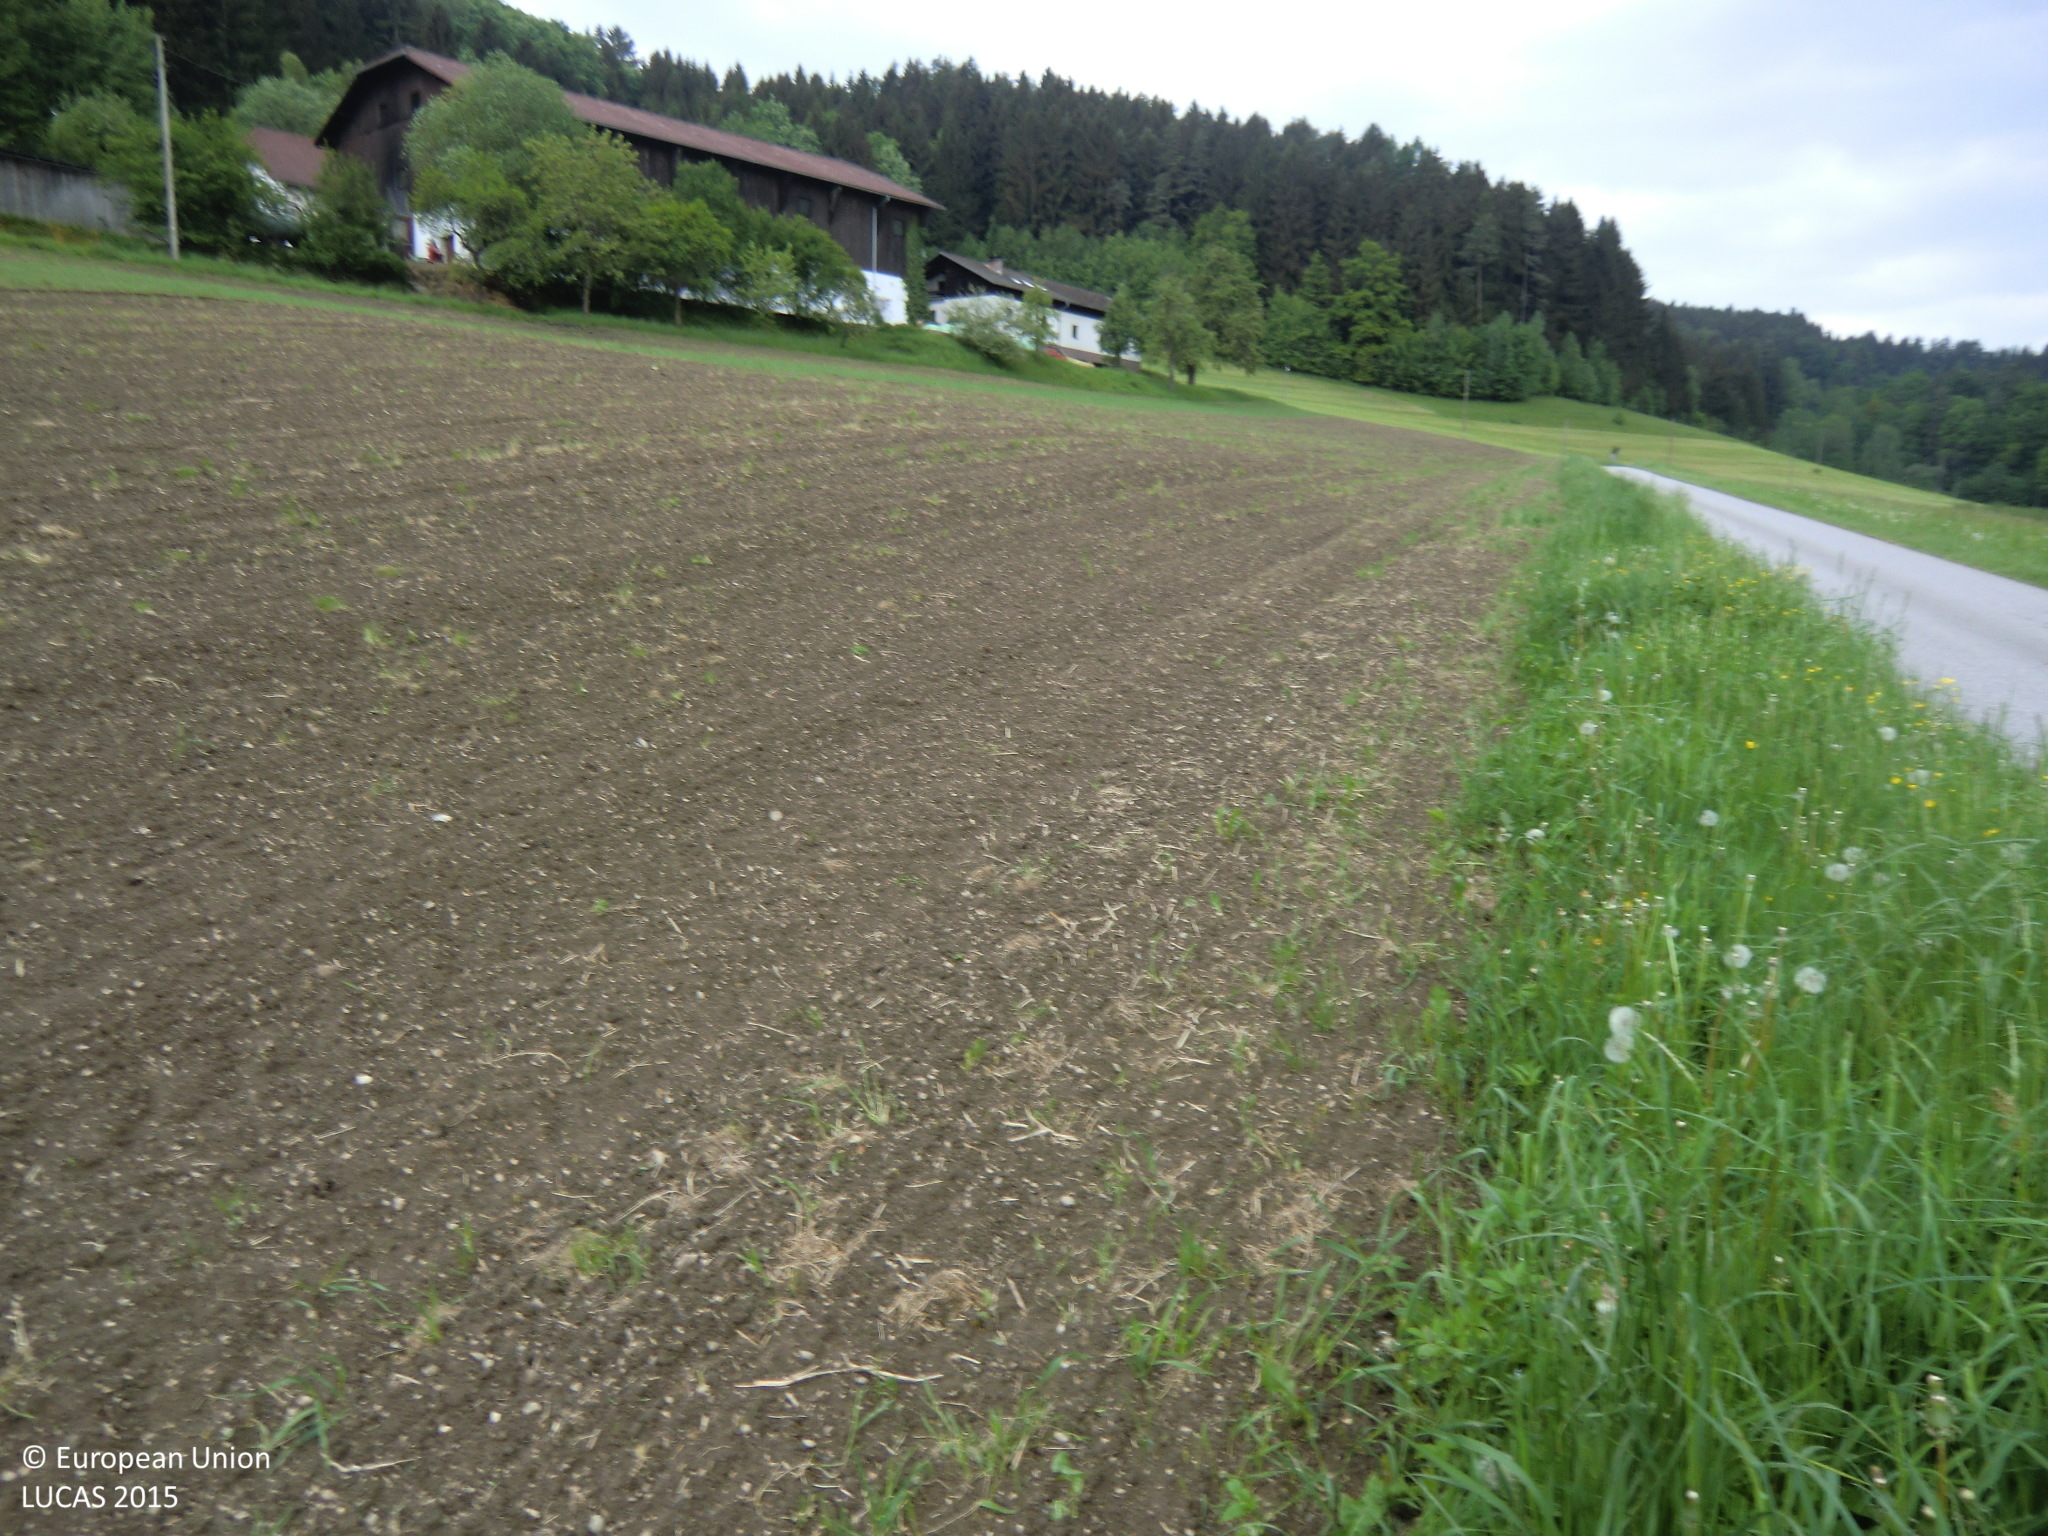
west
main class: Cropland
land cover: Maize
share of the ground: < 10 %
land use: Agriculture (excluding fallow land and kitchen gardens)
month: May
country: AT
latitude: 48.4761
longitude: 14.4511
